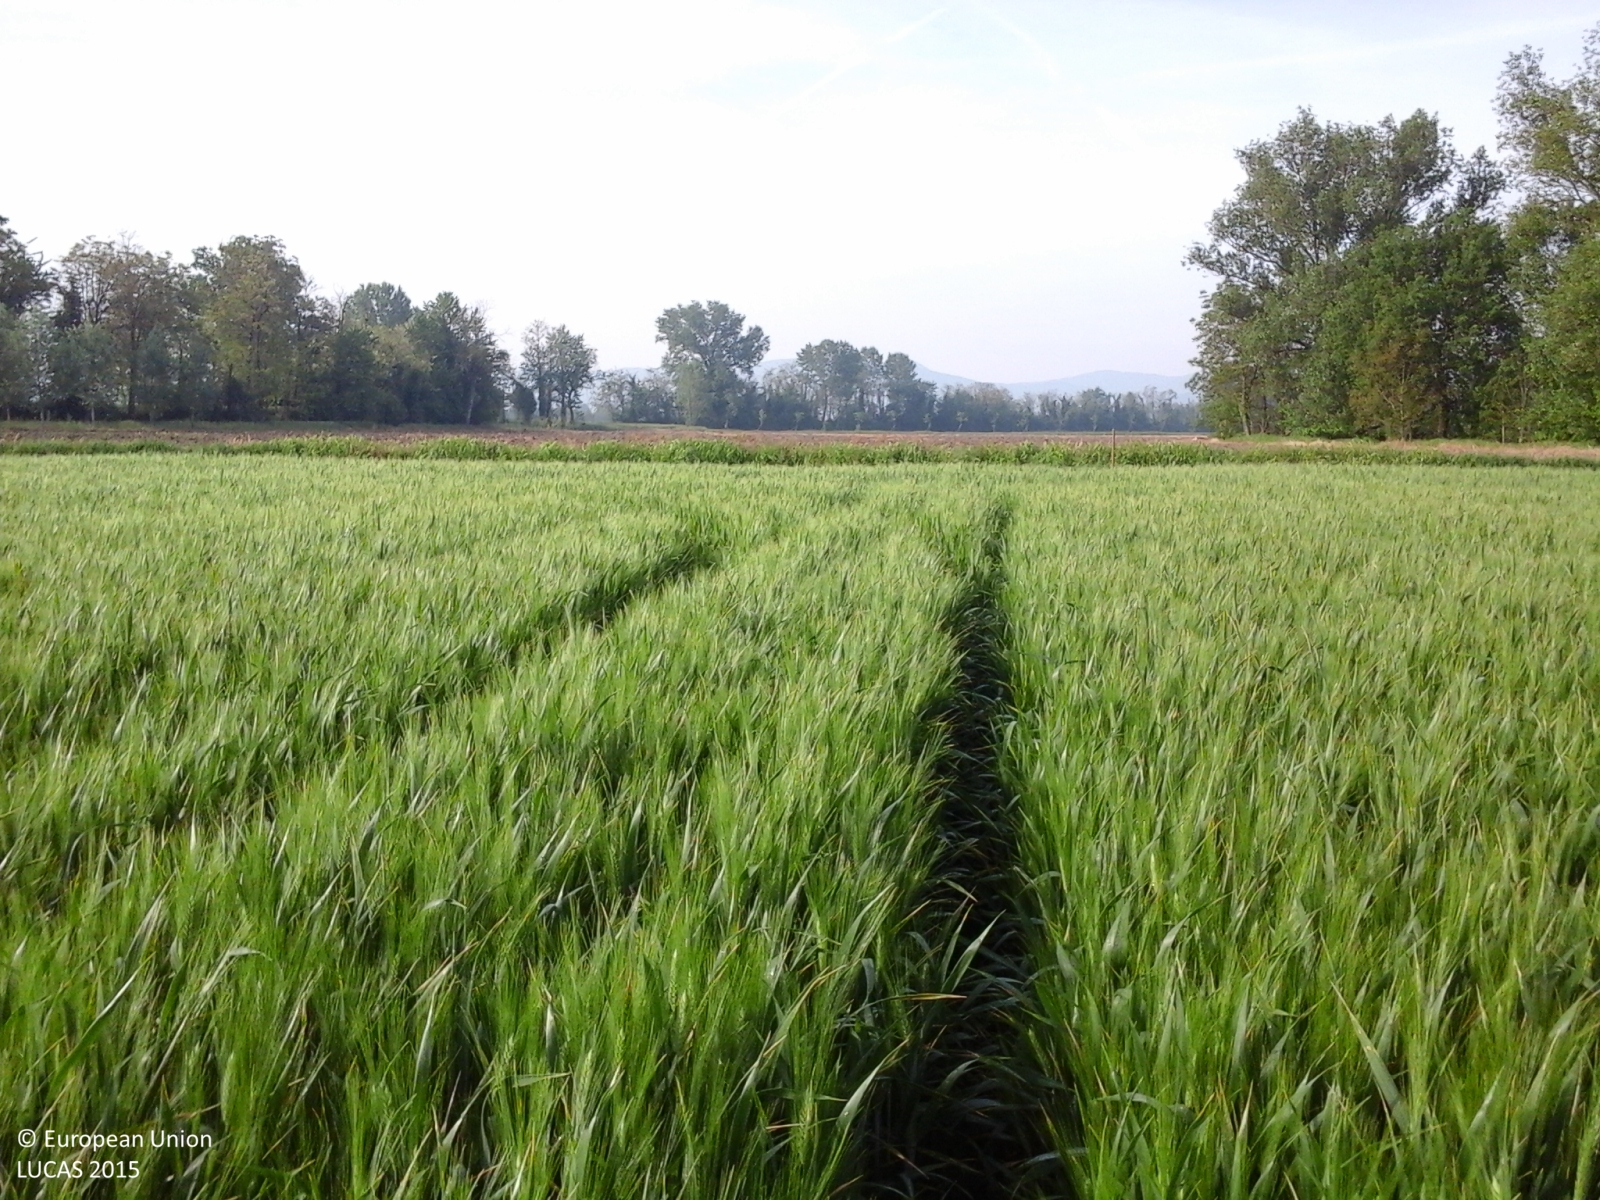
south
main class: Cropland
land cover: Common wheat
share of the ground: > 75 %
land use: Agriculture (excluding fallow land and kitchen gardens)
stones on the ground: < 10 %
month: May
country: IT
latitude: 44.9629
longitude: 9.6078
